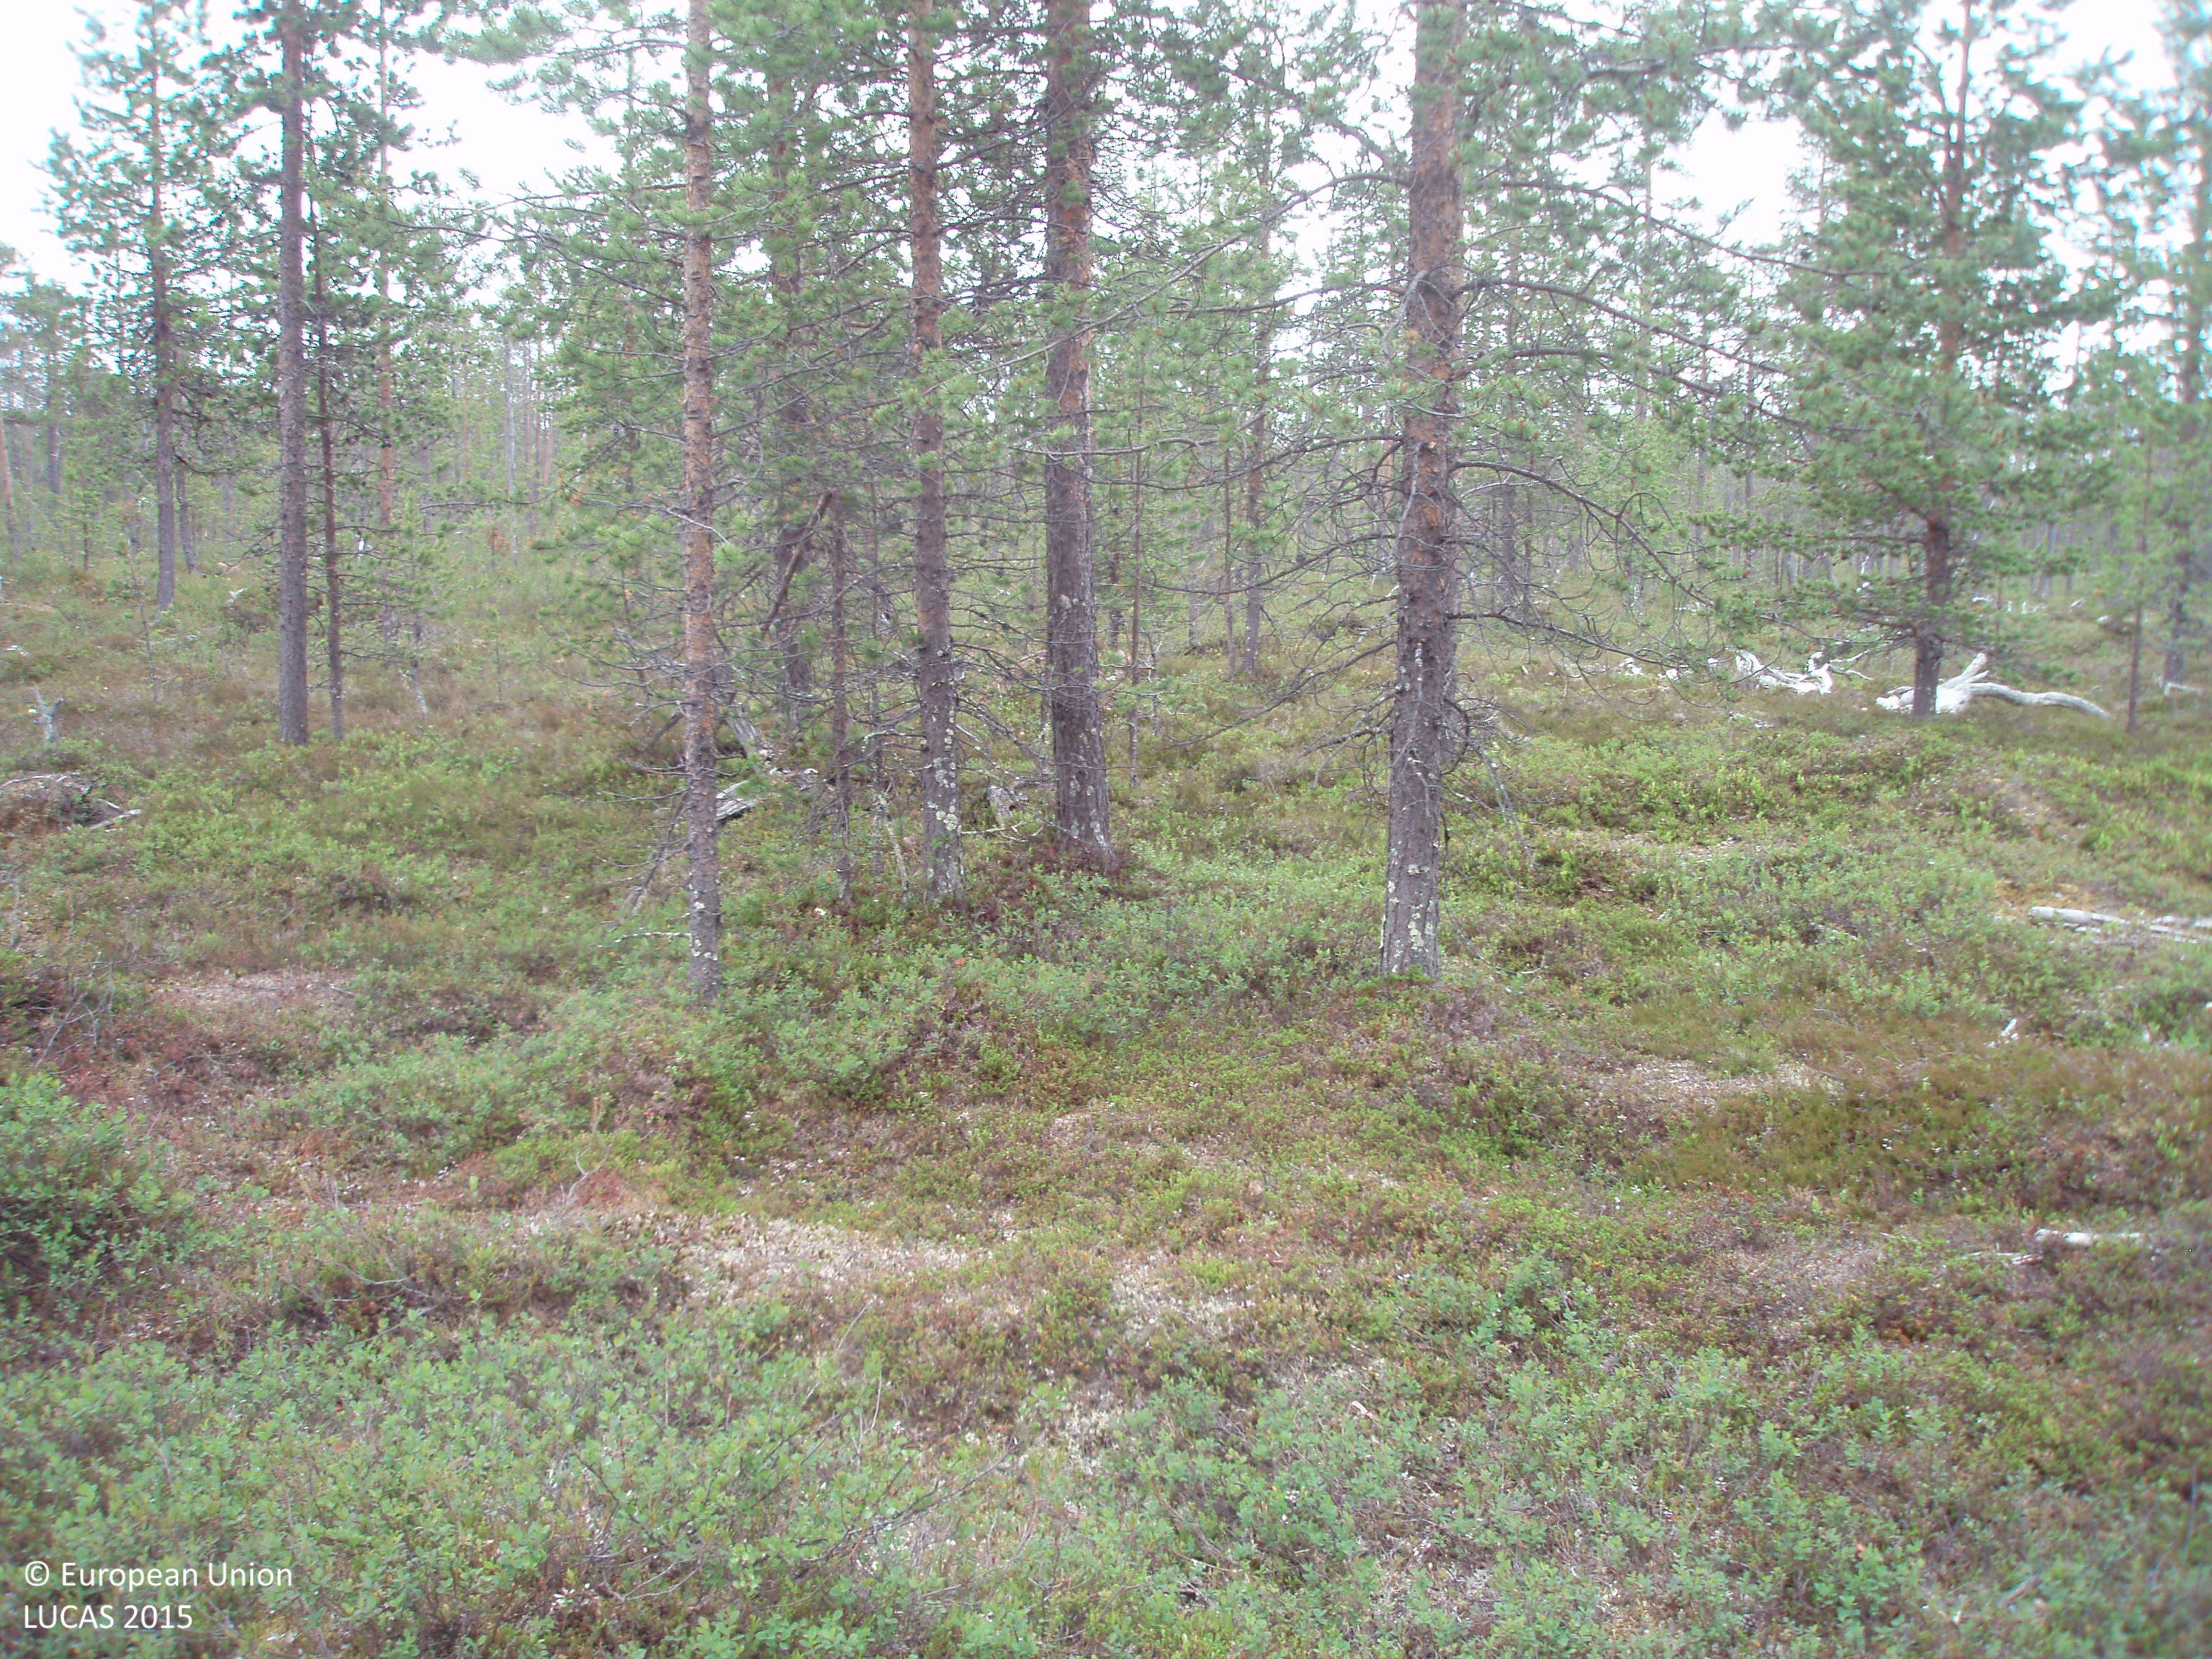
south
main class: Woodland
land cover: Pine dominated coniferous woodland
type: boreal forest
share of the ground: 25 - 50 %
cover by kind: shrubs 60 %, coniferous forest trees 35 %, lichens and mosses 5 %
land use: Forestry
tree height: < 5 m
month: July
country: FI
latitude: 67.7649
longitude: 29.0639
